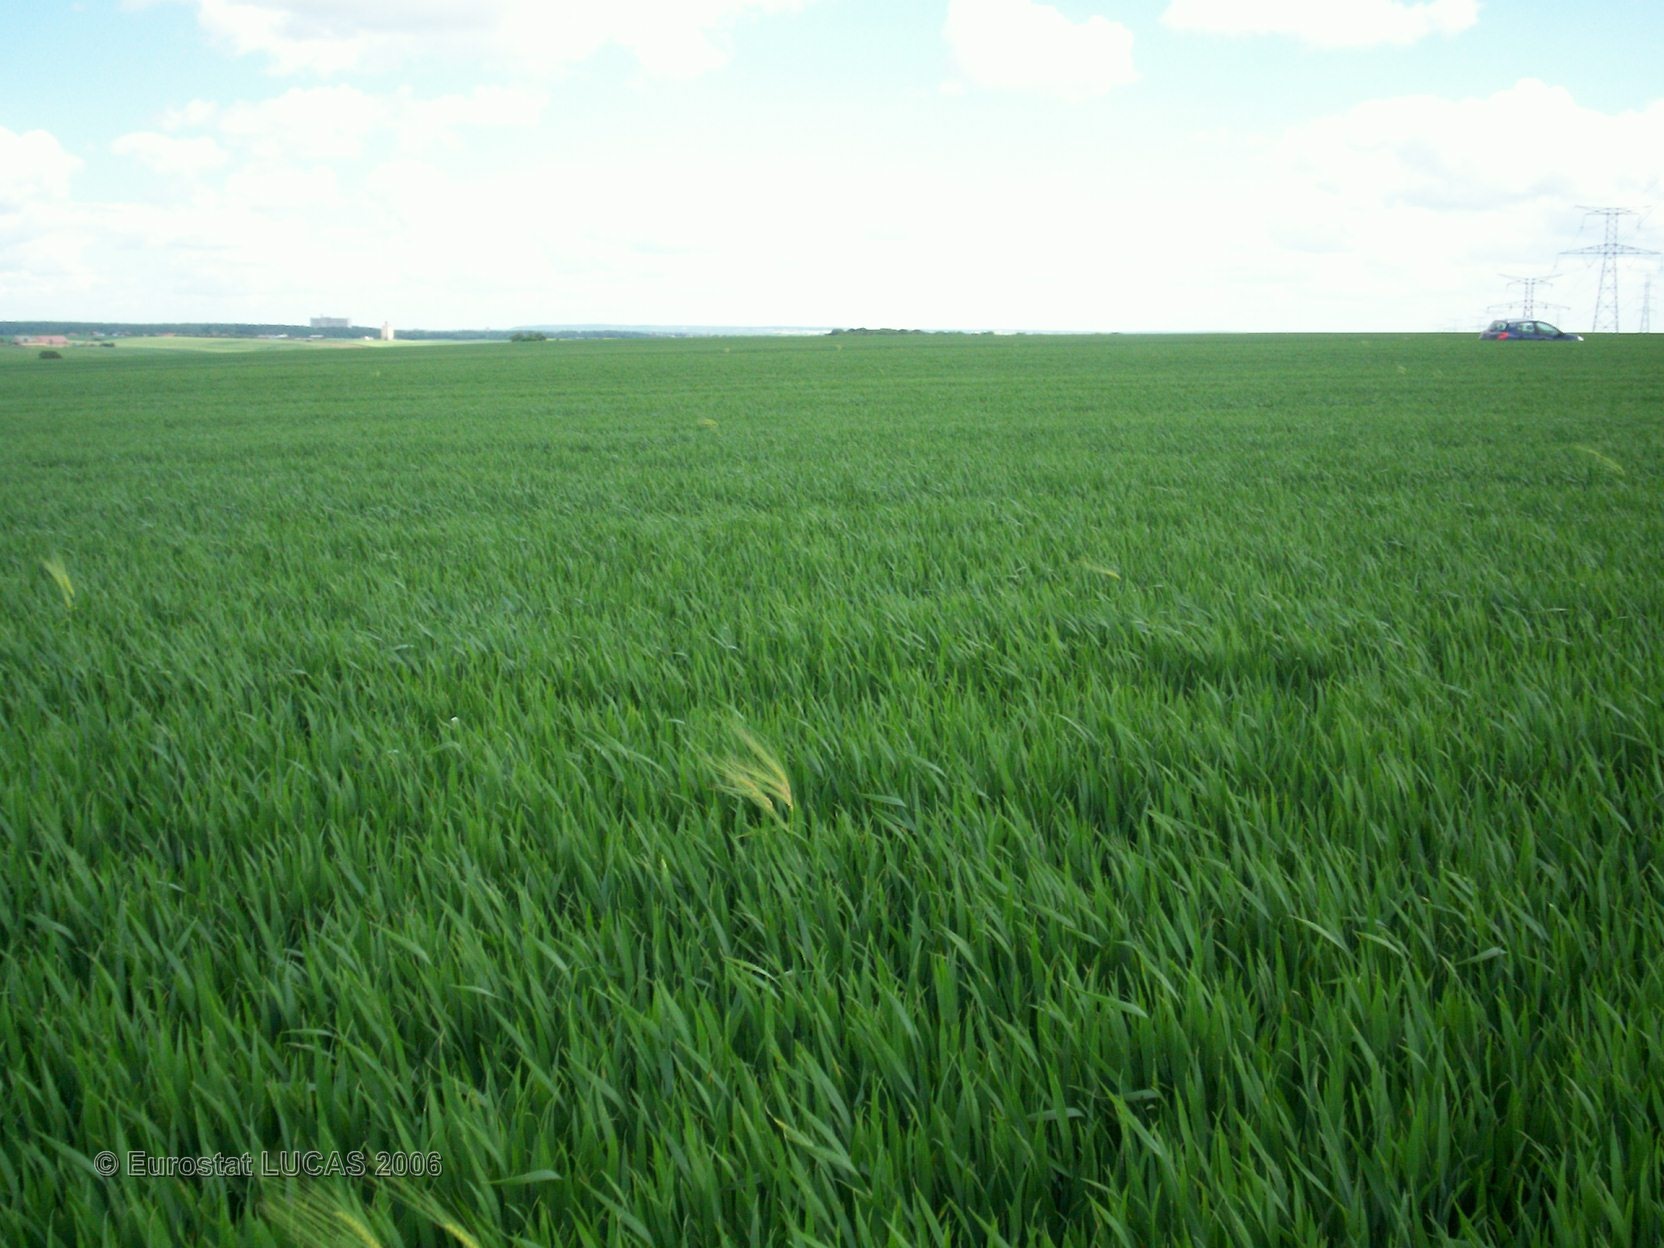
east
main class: Cropland
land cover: Common wheat
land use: Agriculture (excluding fallow land and kitchen gardens)
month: May
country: FR
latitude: 49.2628
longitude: 5.8630
